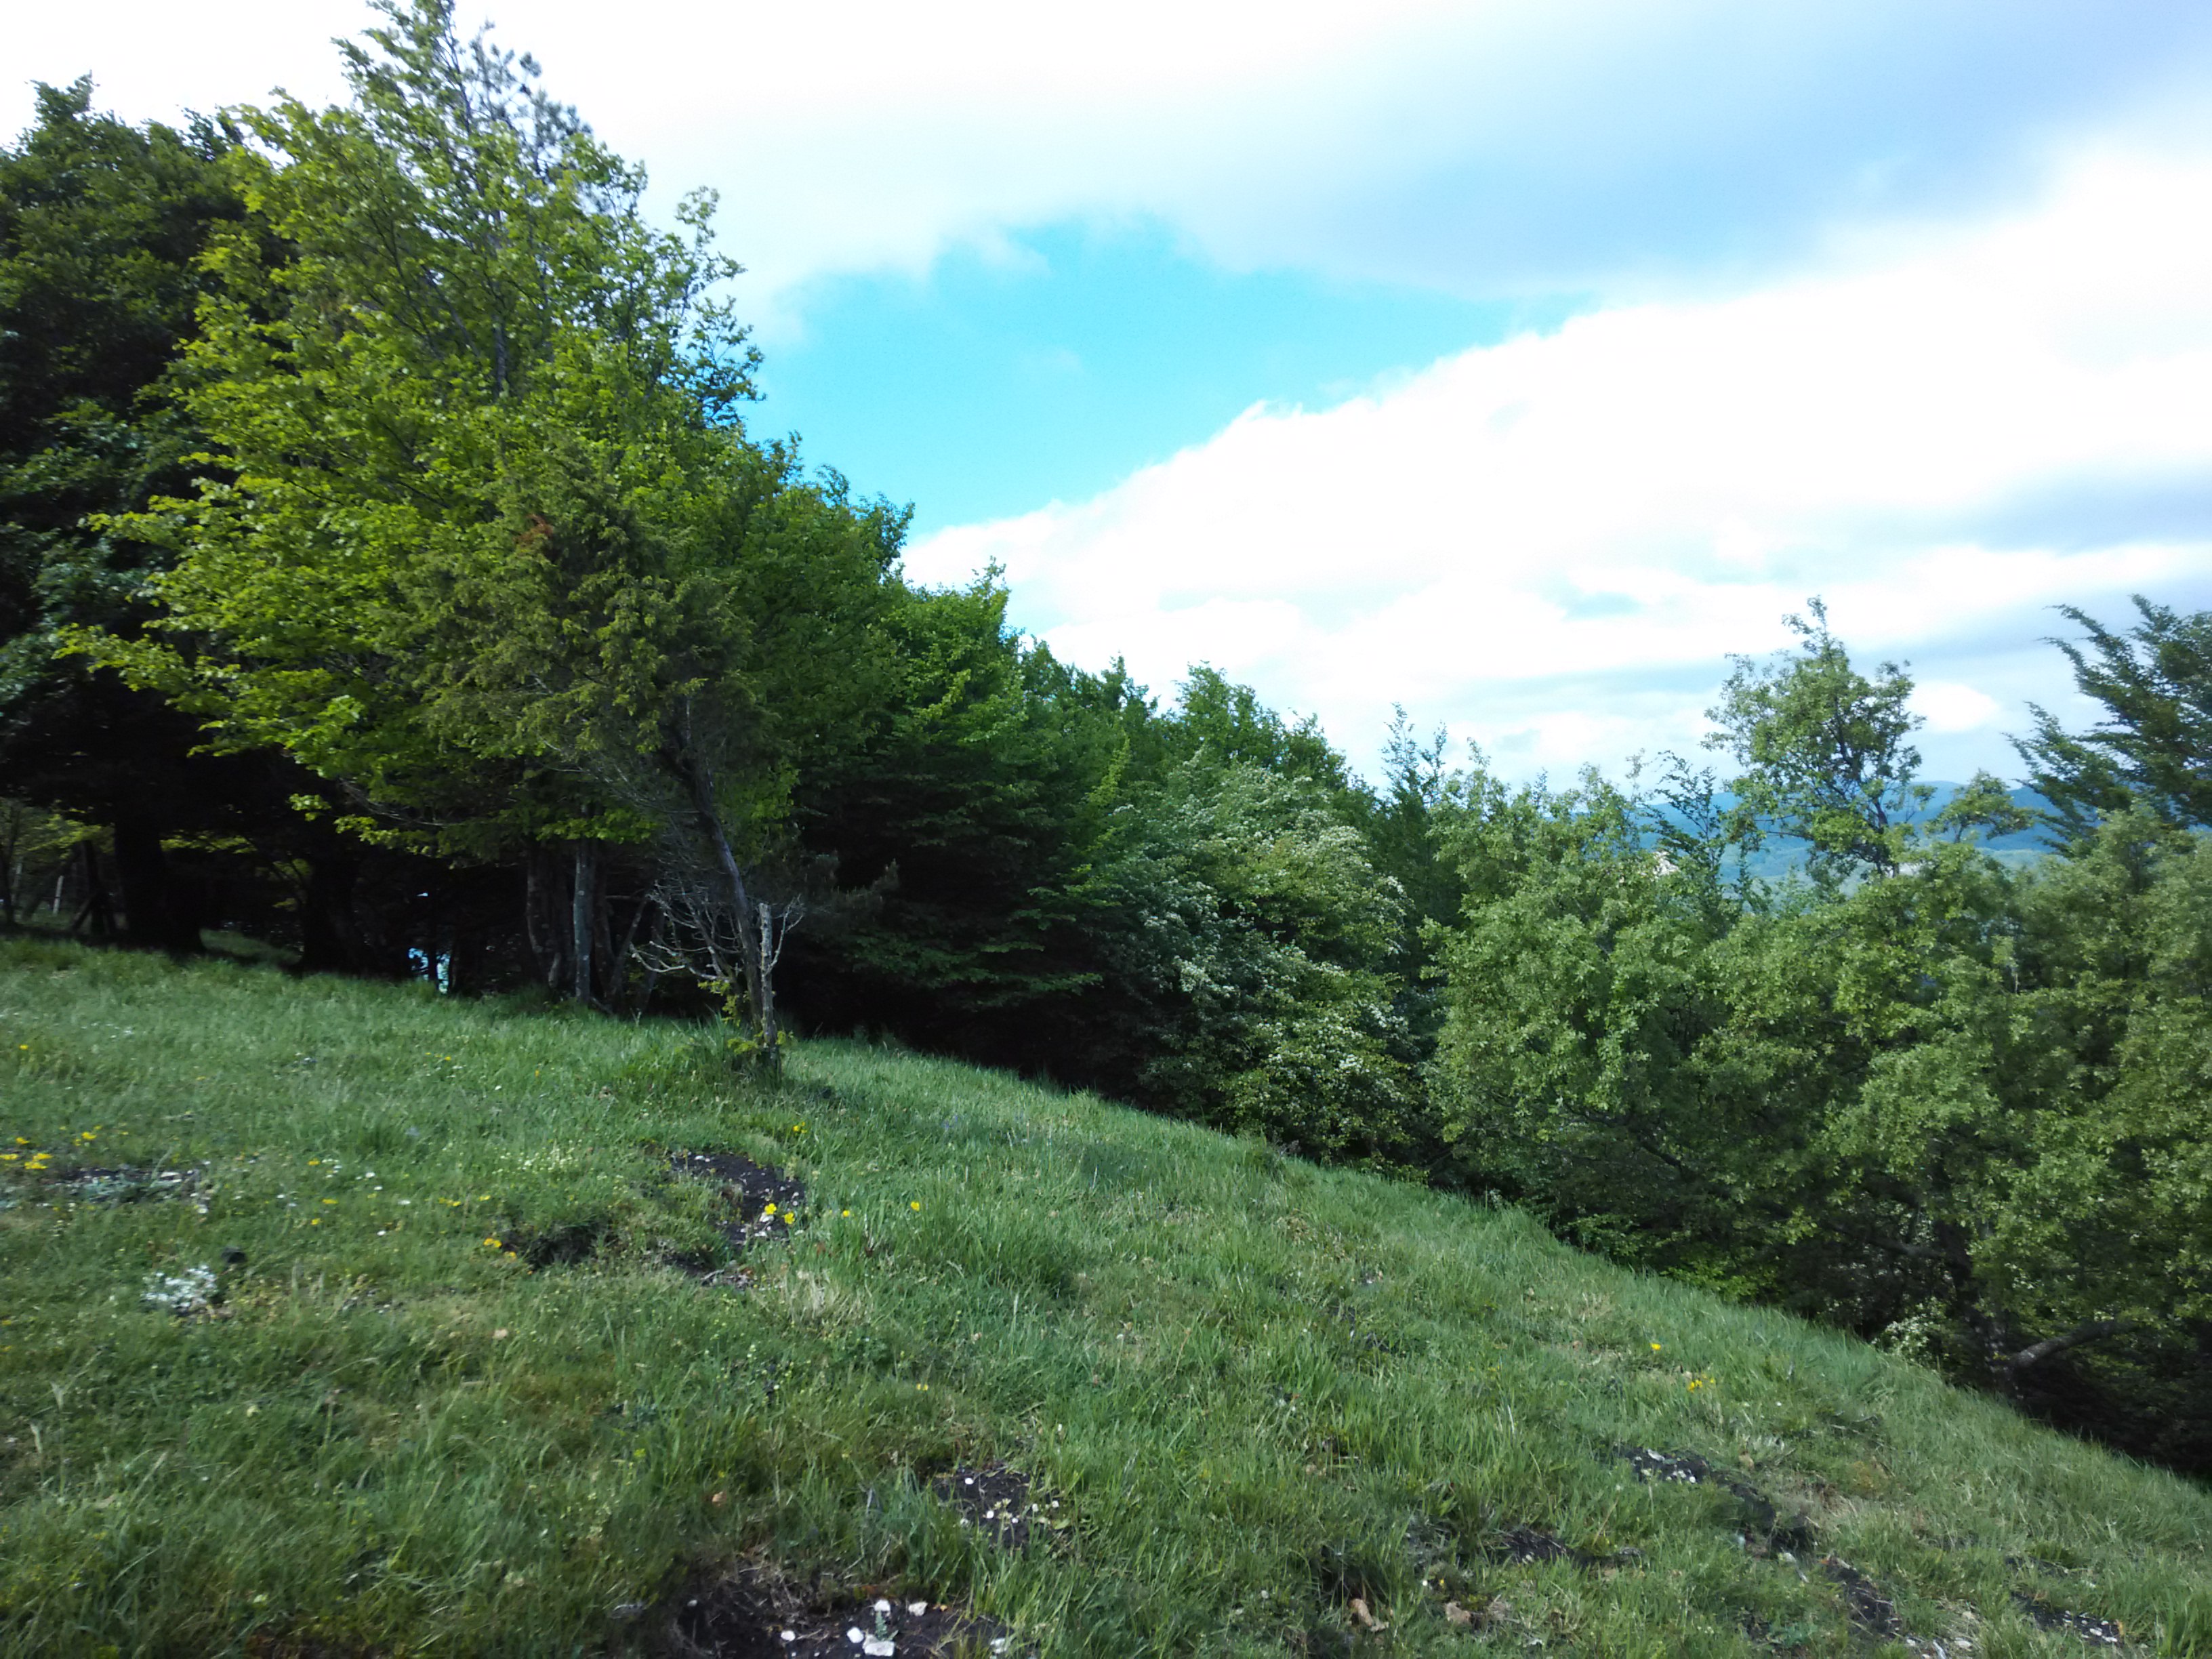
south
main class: Woodland
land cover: Broadleaved woodland
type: beech forest
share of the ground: > 75 %
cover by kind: broadleaved forest trees 70 %, coniferous forest trees 20 %, shrubs 5 %, herbaceous plants 5 %
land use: Forestry
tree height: > 5 m
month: May
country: ES
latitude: 42.7971
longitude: -2.4333
